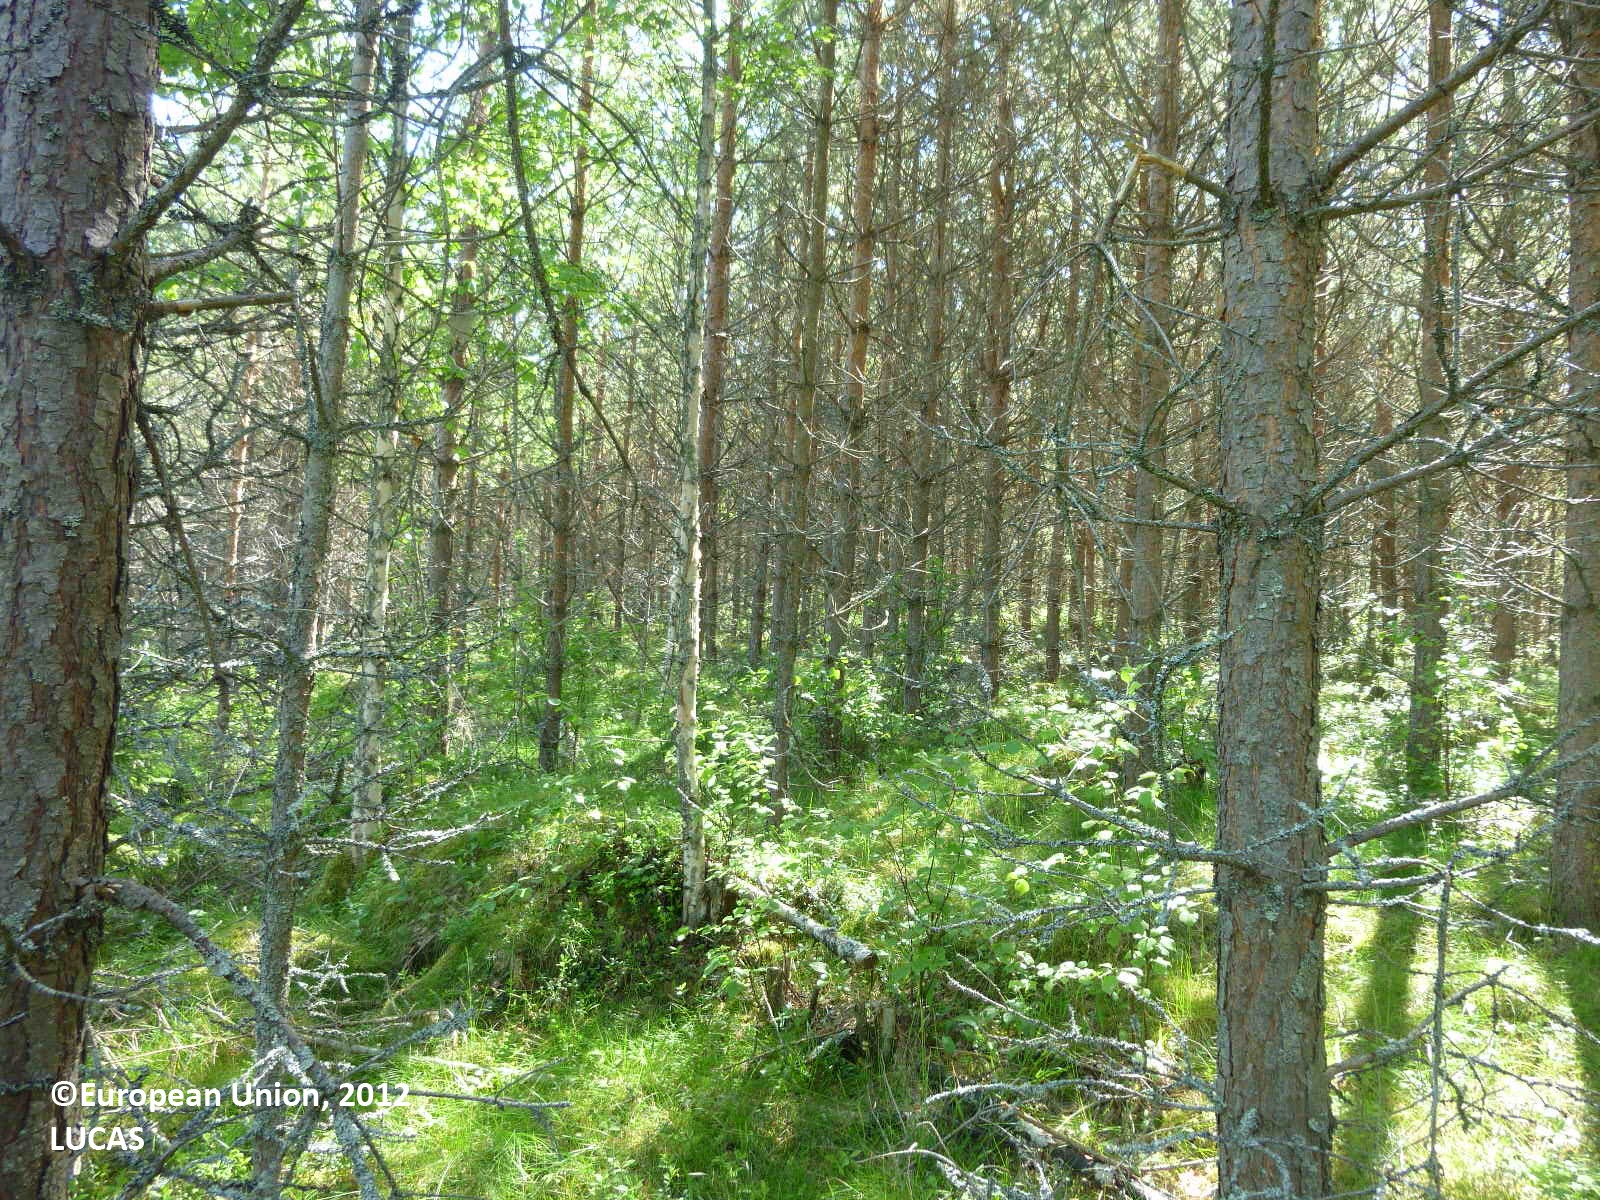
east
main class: Woodland
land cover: Pine dominated coniferous woodland
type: boreal forest
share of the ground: 50 - 75 %
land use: Forestry
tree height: > 5 m
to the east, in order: Pine dominated coniferous woodland; Grass margins; Electric lines; Grass margins; Spruce dominated coniferous woodland; Spruce dominated mixed woodland; Grassland without tree/shrub cover
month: June
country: FI
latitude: 61.6334
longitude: 22.2665
